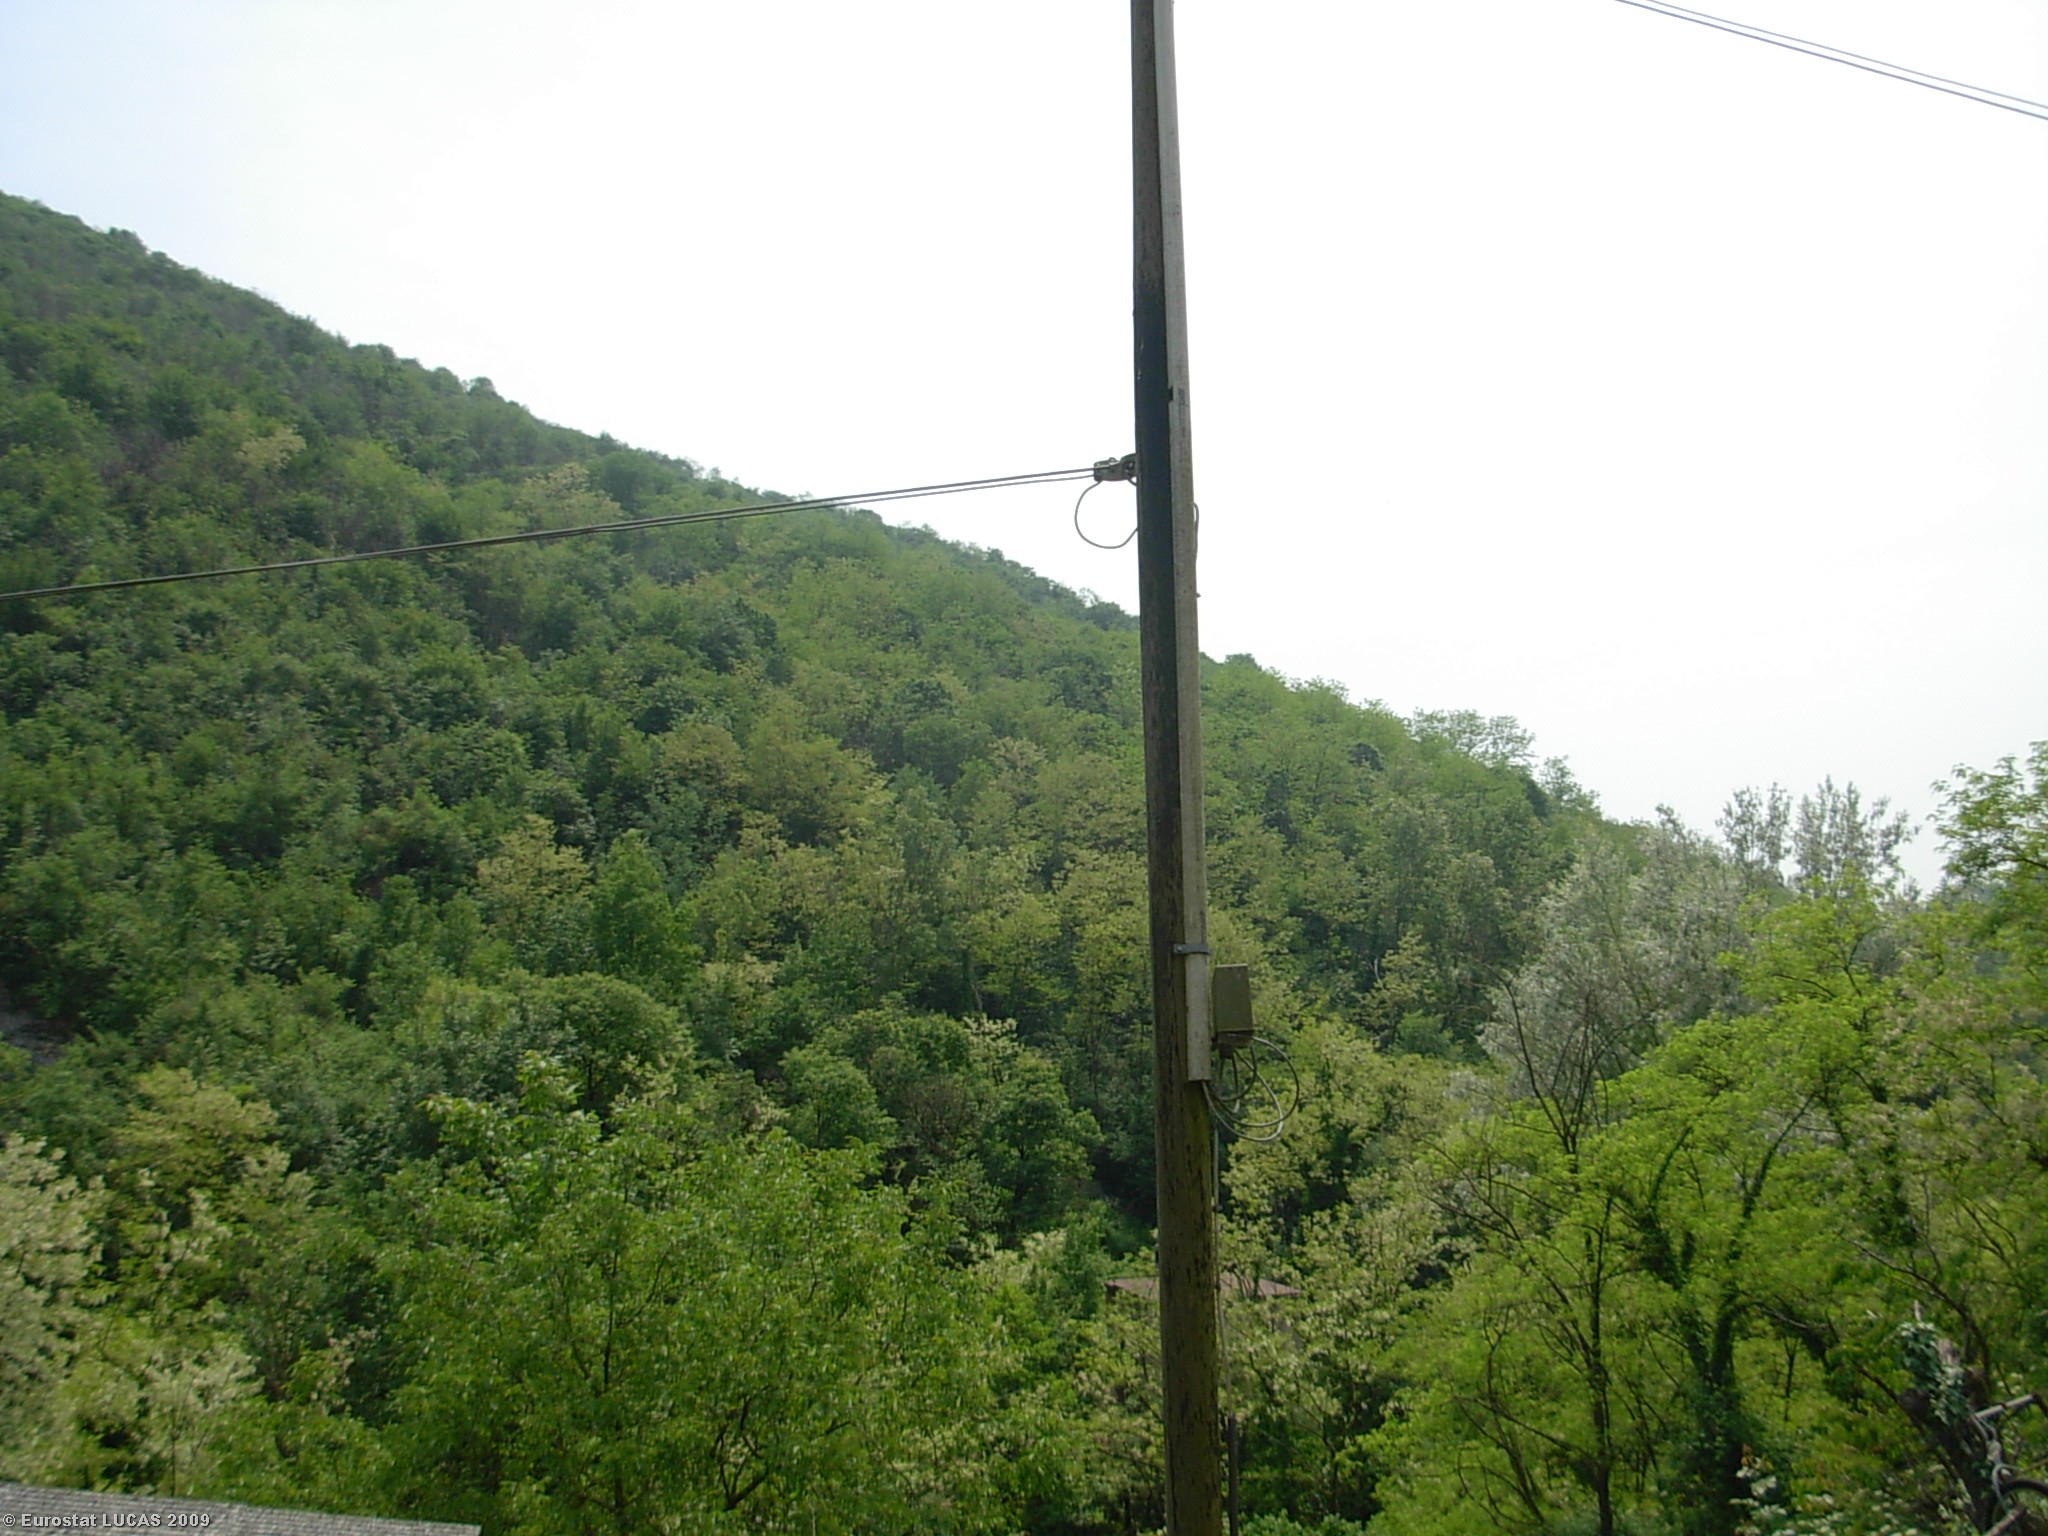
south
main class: Woodland
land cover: Broadleaved woodland
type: mountainous beech forest
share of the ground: > 75 %
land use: Unused
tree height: > 5 m
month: May
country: IT
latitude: 45.5580
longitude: 10.3197
